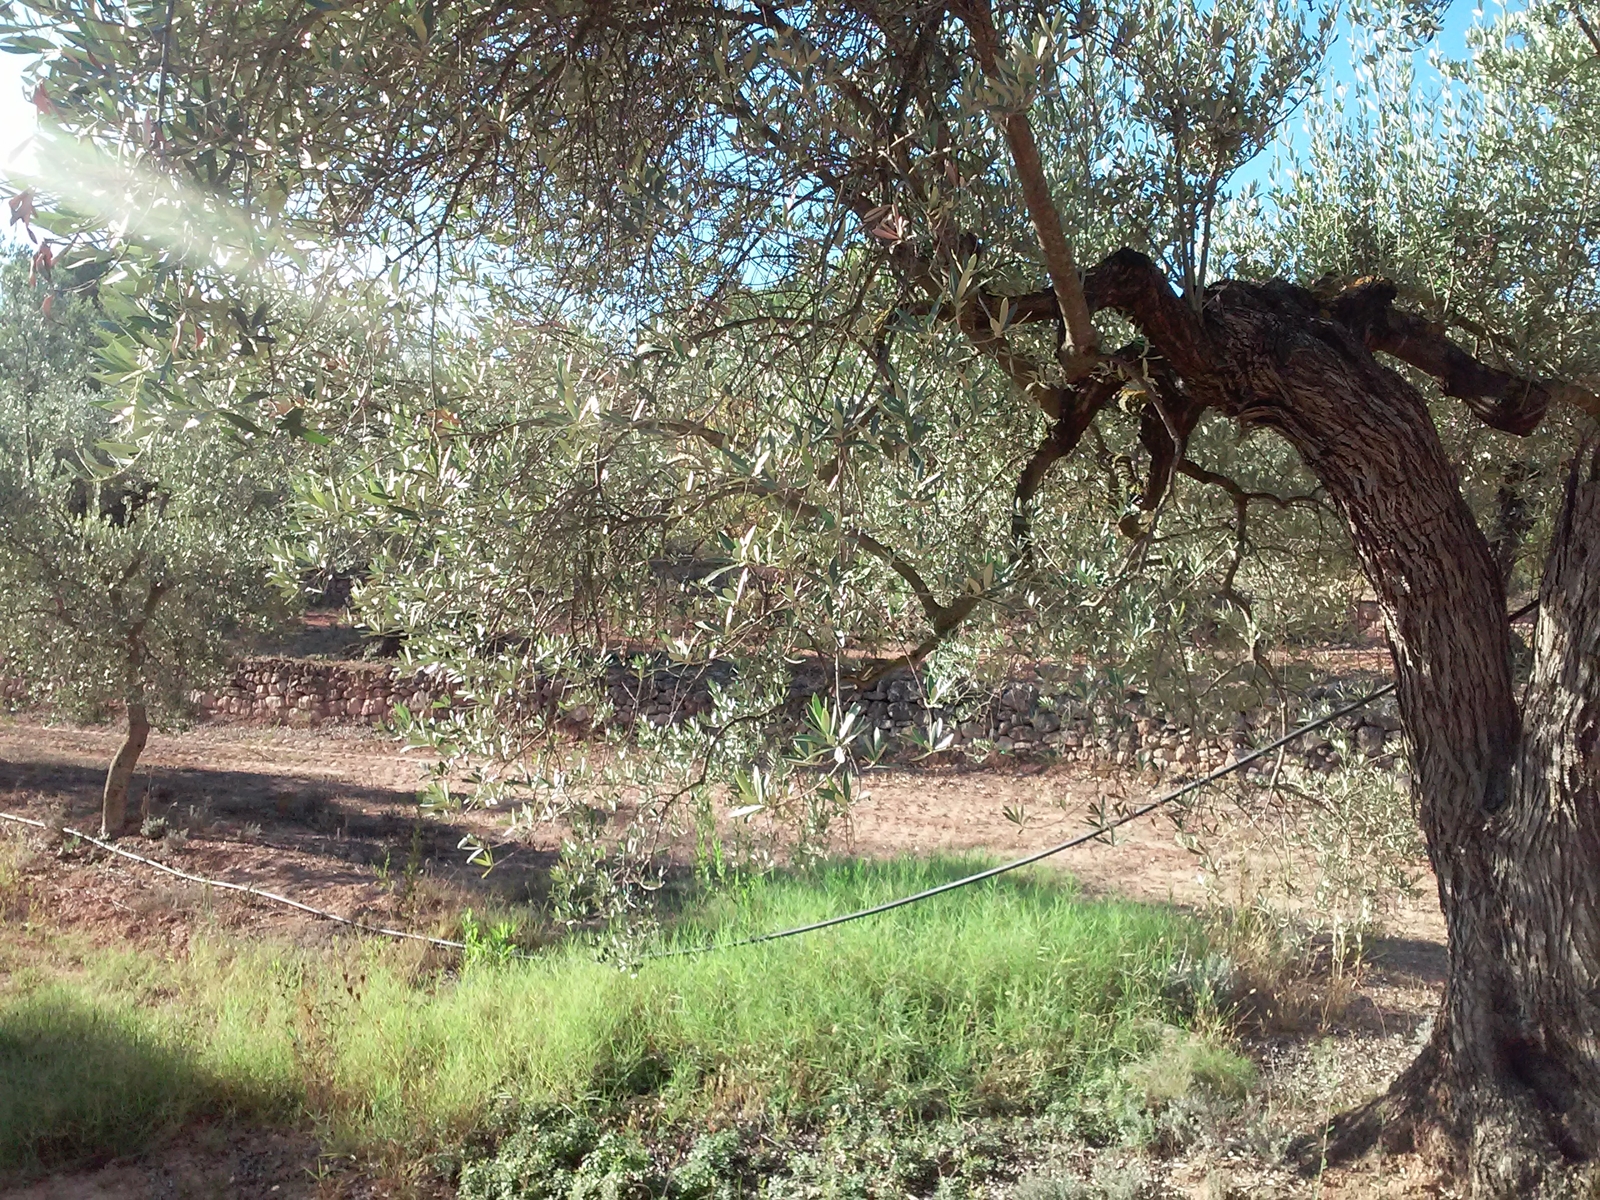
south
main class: Cropland
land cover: Olive groves
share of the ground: 25 - 50 %
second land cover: Other bare soil
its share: > 75 %
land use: Agriculture (excluding fallow land and kitchen gardens)
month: September
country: ES
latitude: 41.1919
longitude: 0.5357
